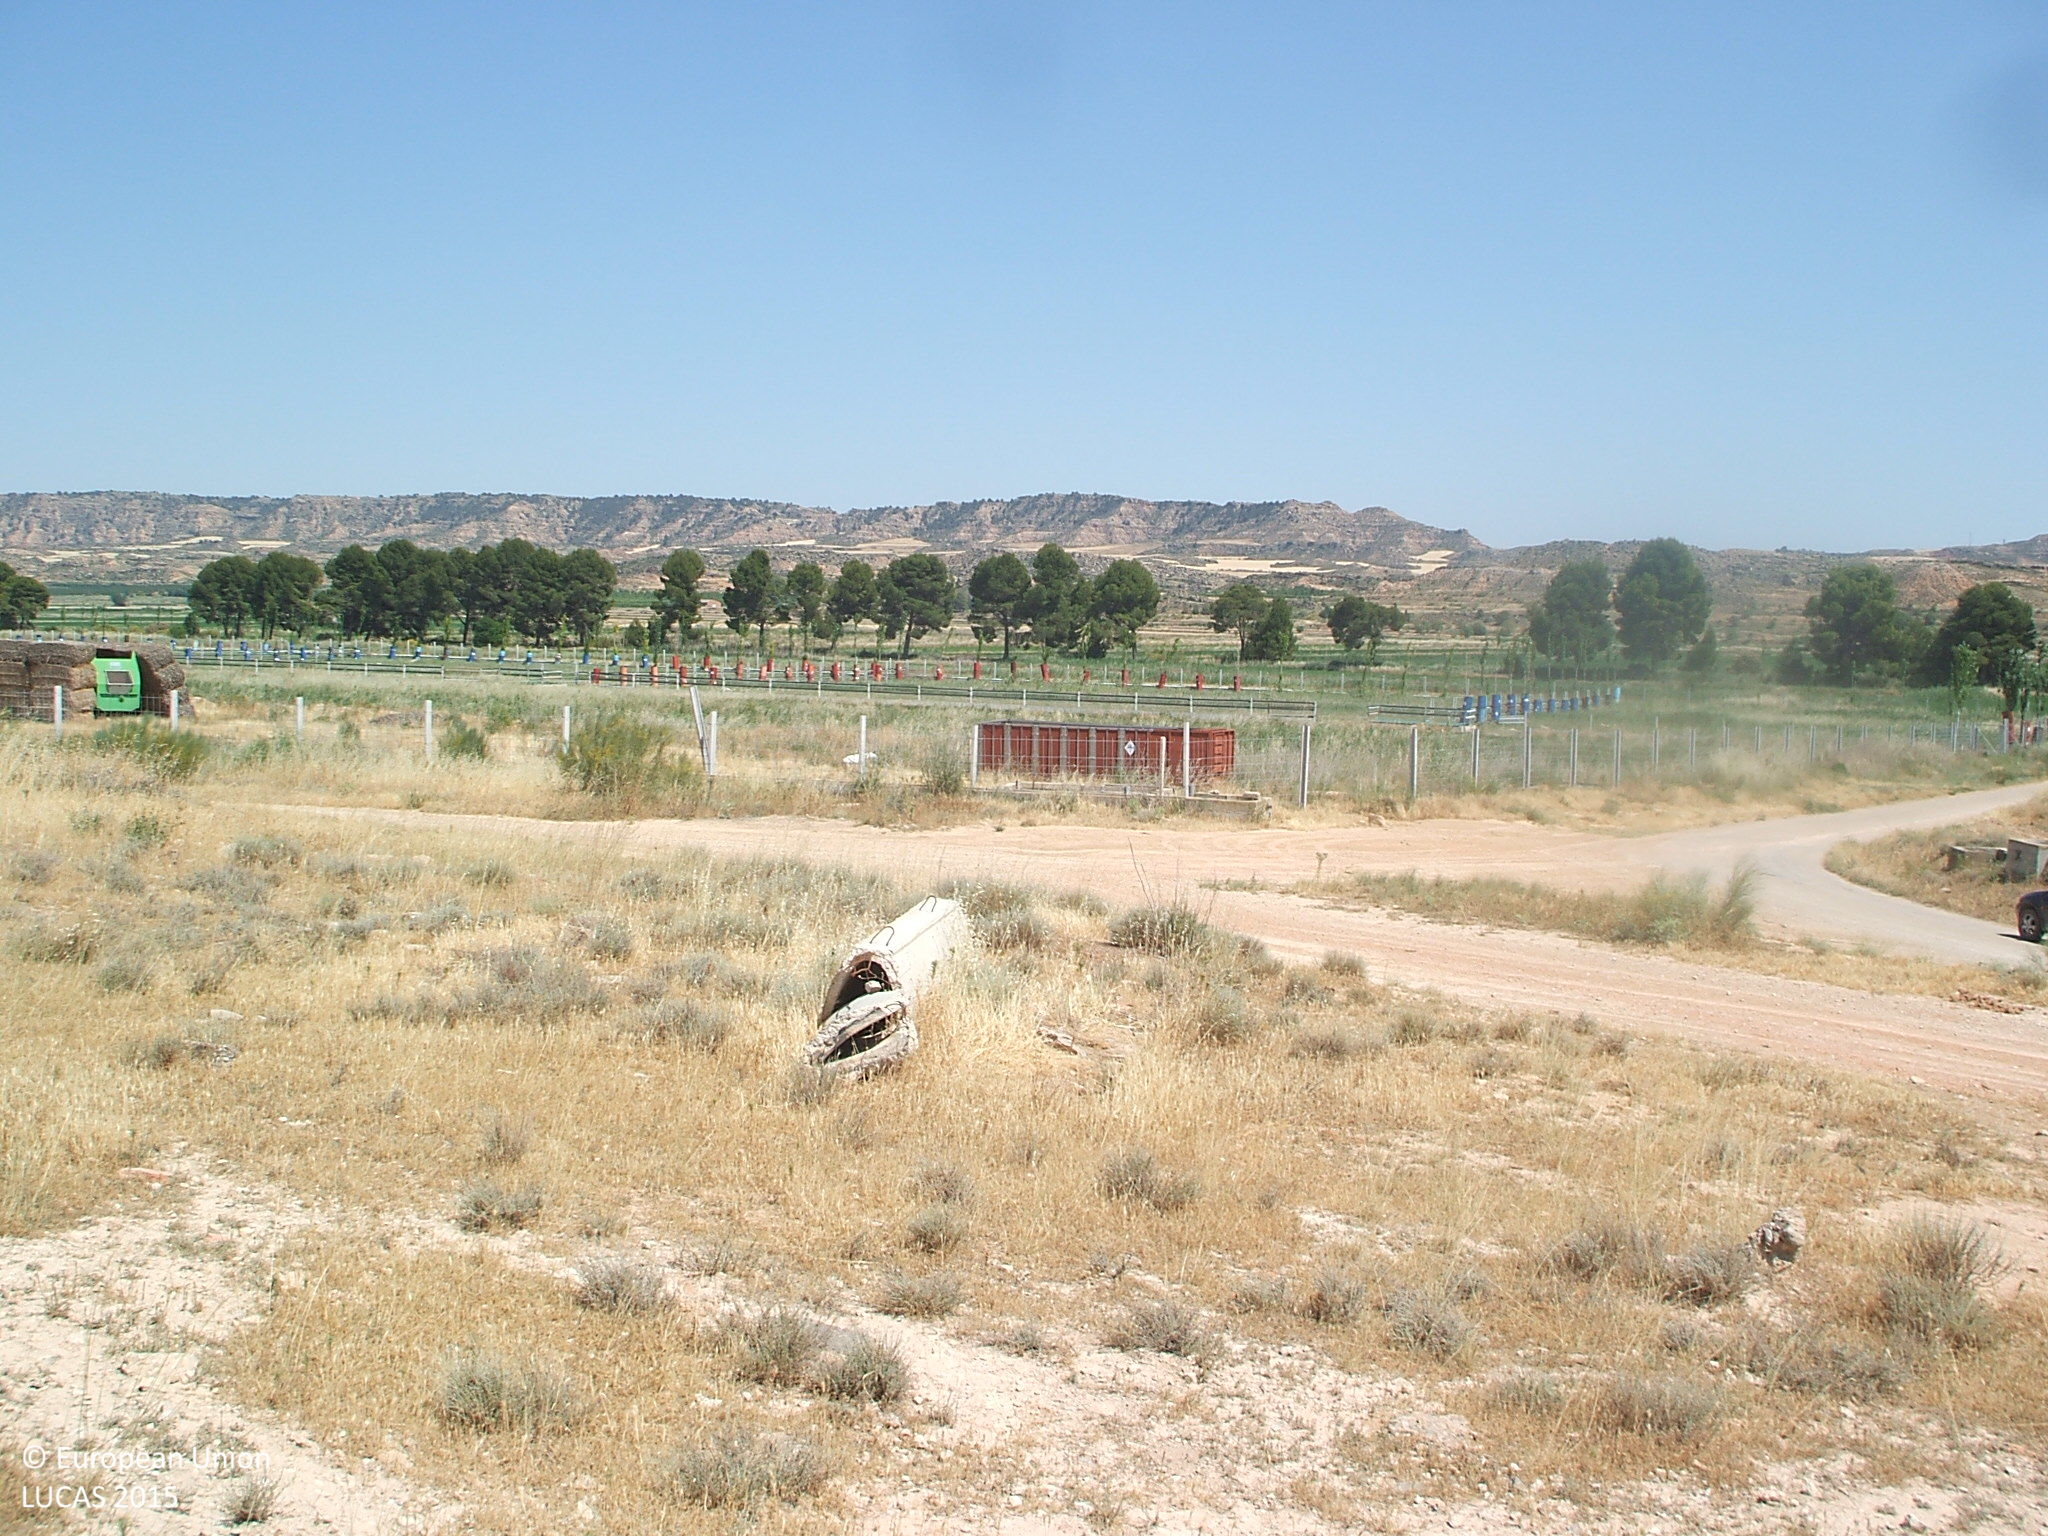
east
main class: Shrubland
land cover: Shrubland without tree cover
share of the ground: 50 - 75 %
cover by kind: shrubs 50 %, herbaceous plants 30 %, consolidated bare surface 20 %
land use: Semi-natural and natural areas not in use
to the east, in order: Shrubland without tree cover; Tracks; Shrubland without tree cover; Grass margins; Ditches and canals; Grass margins; Fences; Grass margins; Spontaneously vegetated surfaces; Permanent crops (only in case pi); Spontaneously vegetated surfaces
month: June
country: ES
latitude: 41.1168
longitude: -0.2189
